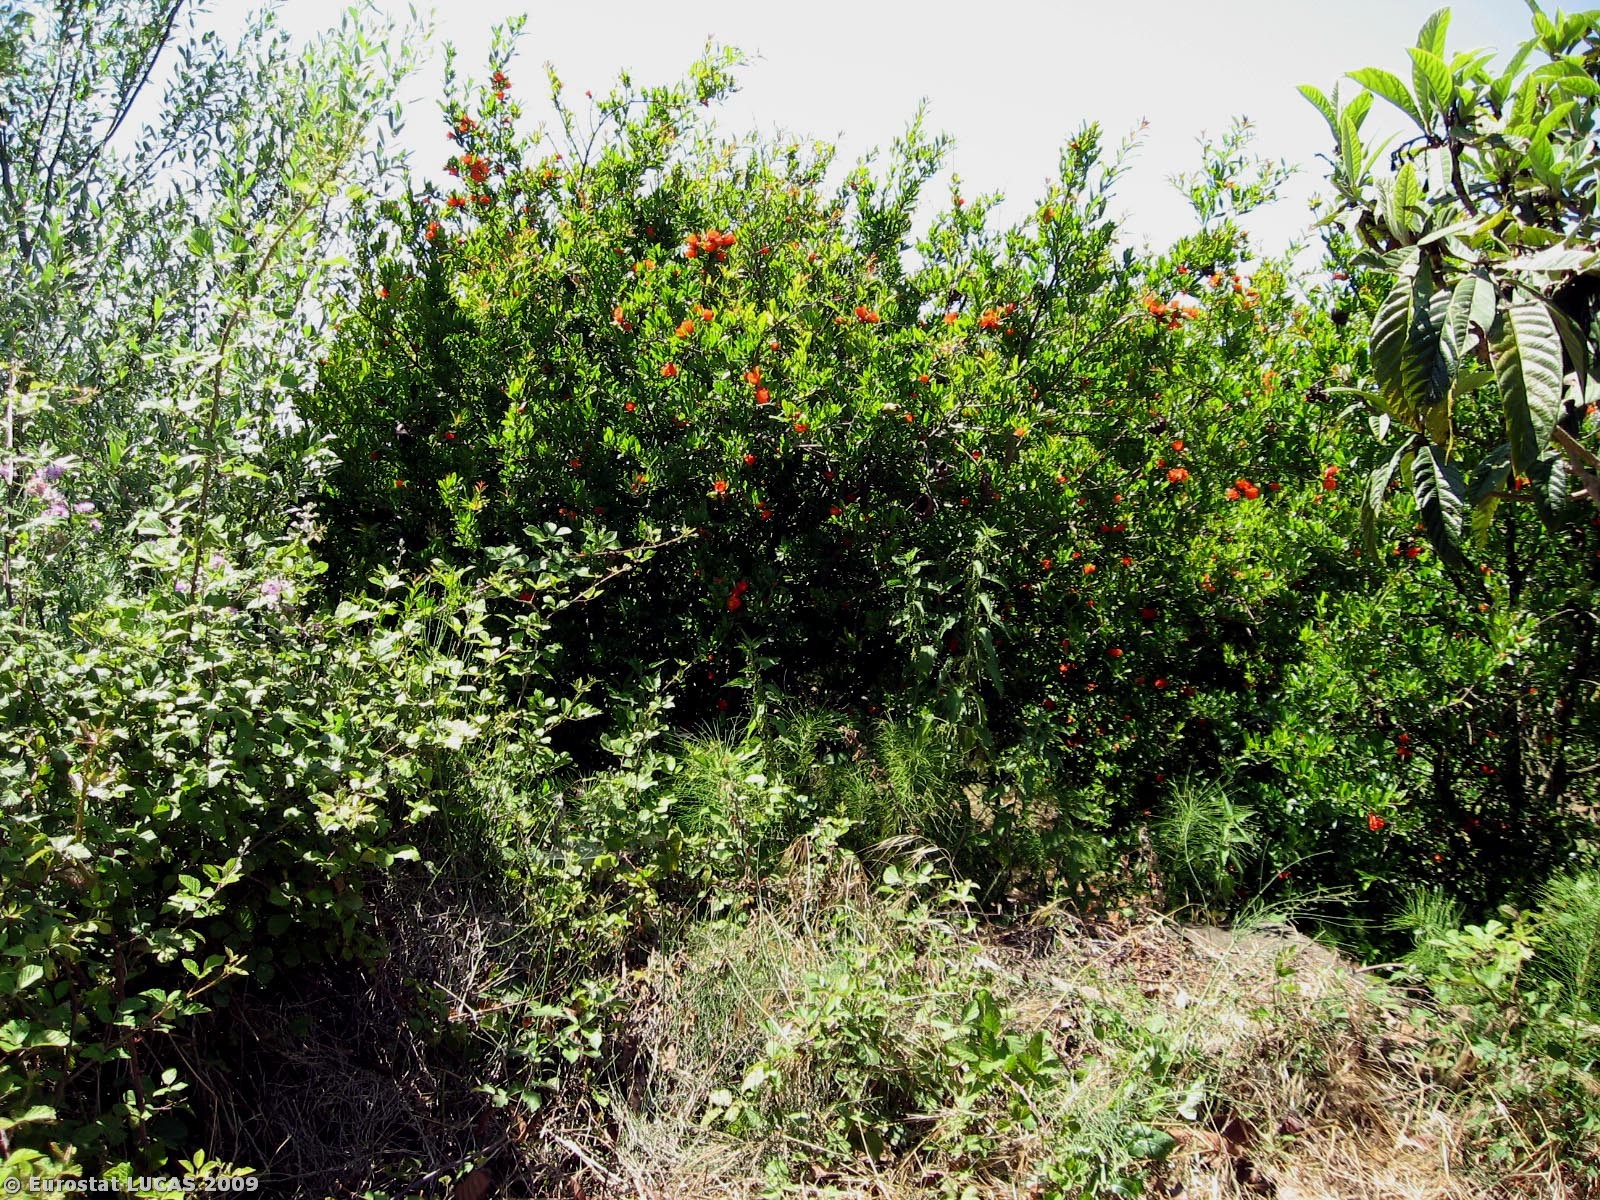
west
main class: Shrubland
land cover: Shrubland with sparse tree cover
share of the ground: > 75 %
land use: Unused
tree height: > 5 m
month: June
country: IT
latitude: 38.8499
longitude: 16.2693
